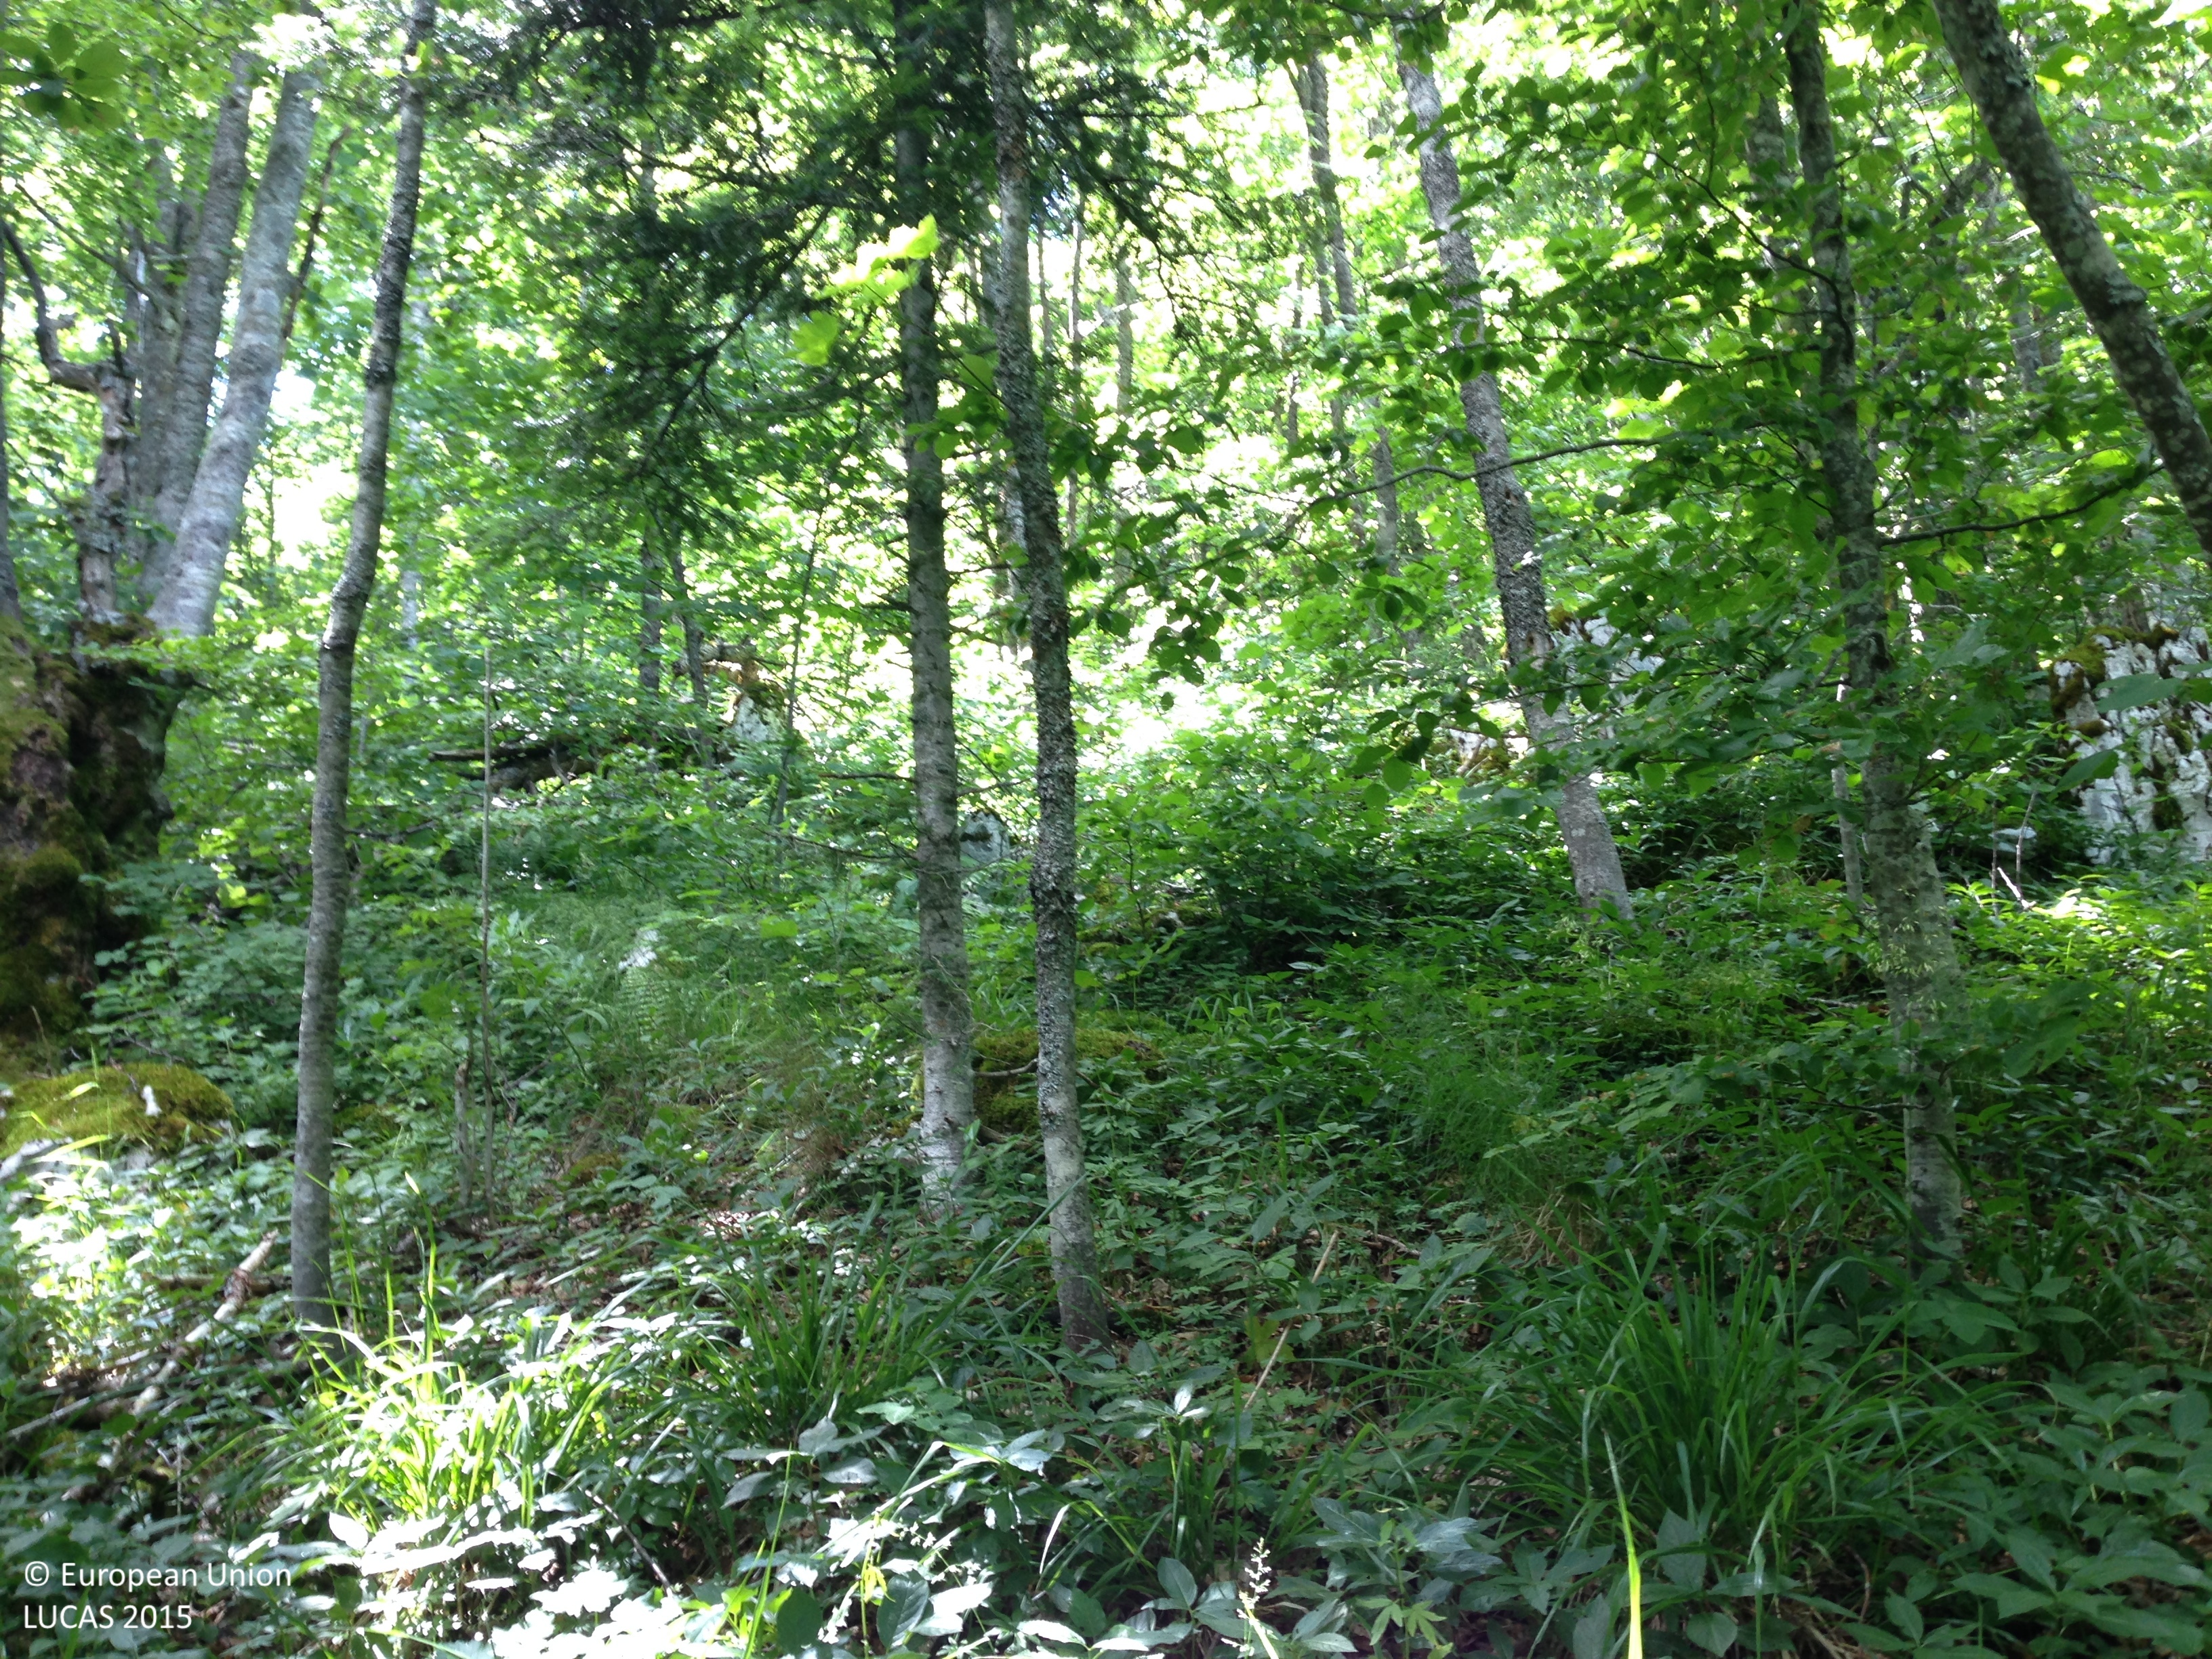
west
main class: Woodland
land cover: Broadleaved woodland
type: thermophilous deciduous forest
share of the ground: > 75 %
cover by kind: broadleaved forest trees 75 %, herbaceous plants 10 %, shrubs 5 %, consolidated bare surface 5 %, unconsolidated bare surface 5 %
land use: Forestry
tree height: > 5 m
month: June
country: HR
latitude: 44.6716
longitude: 15.8850
